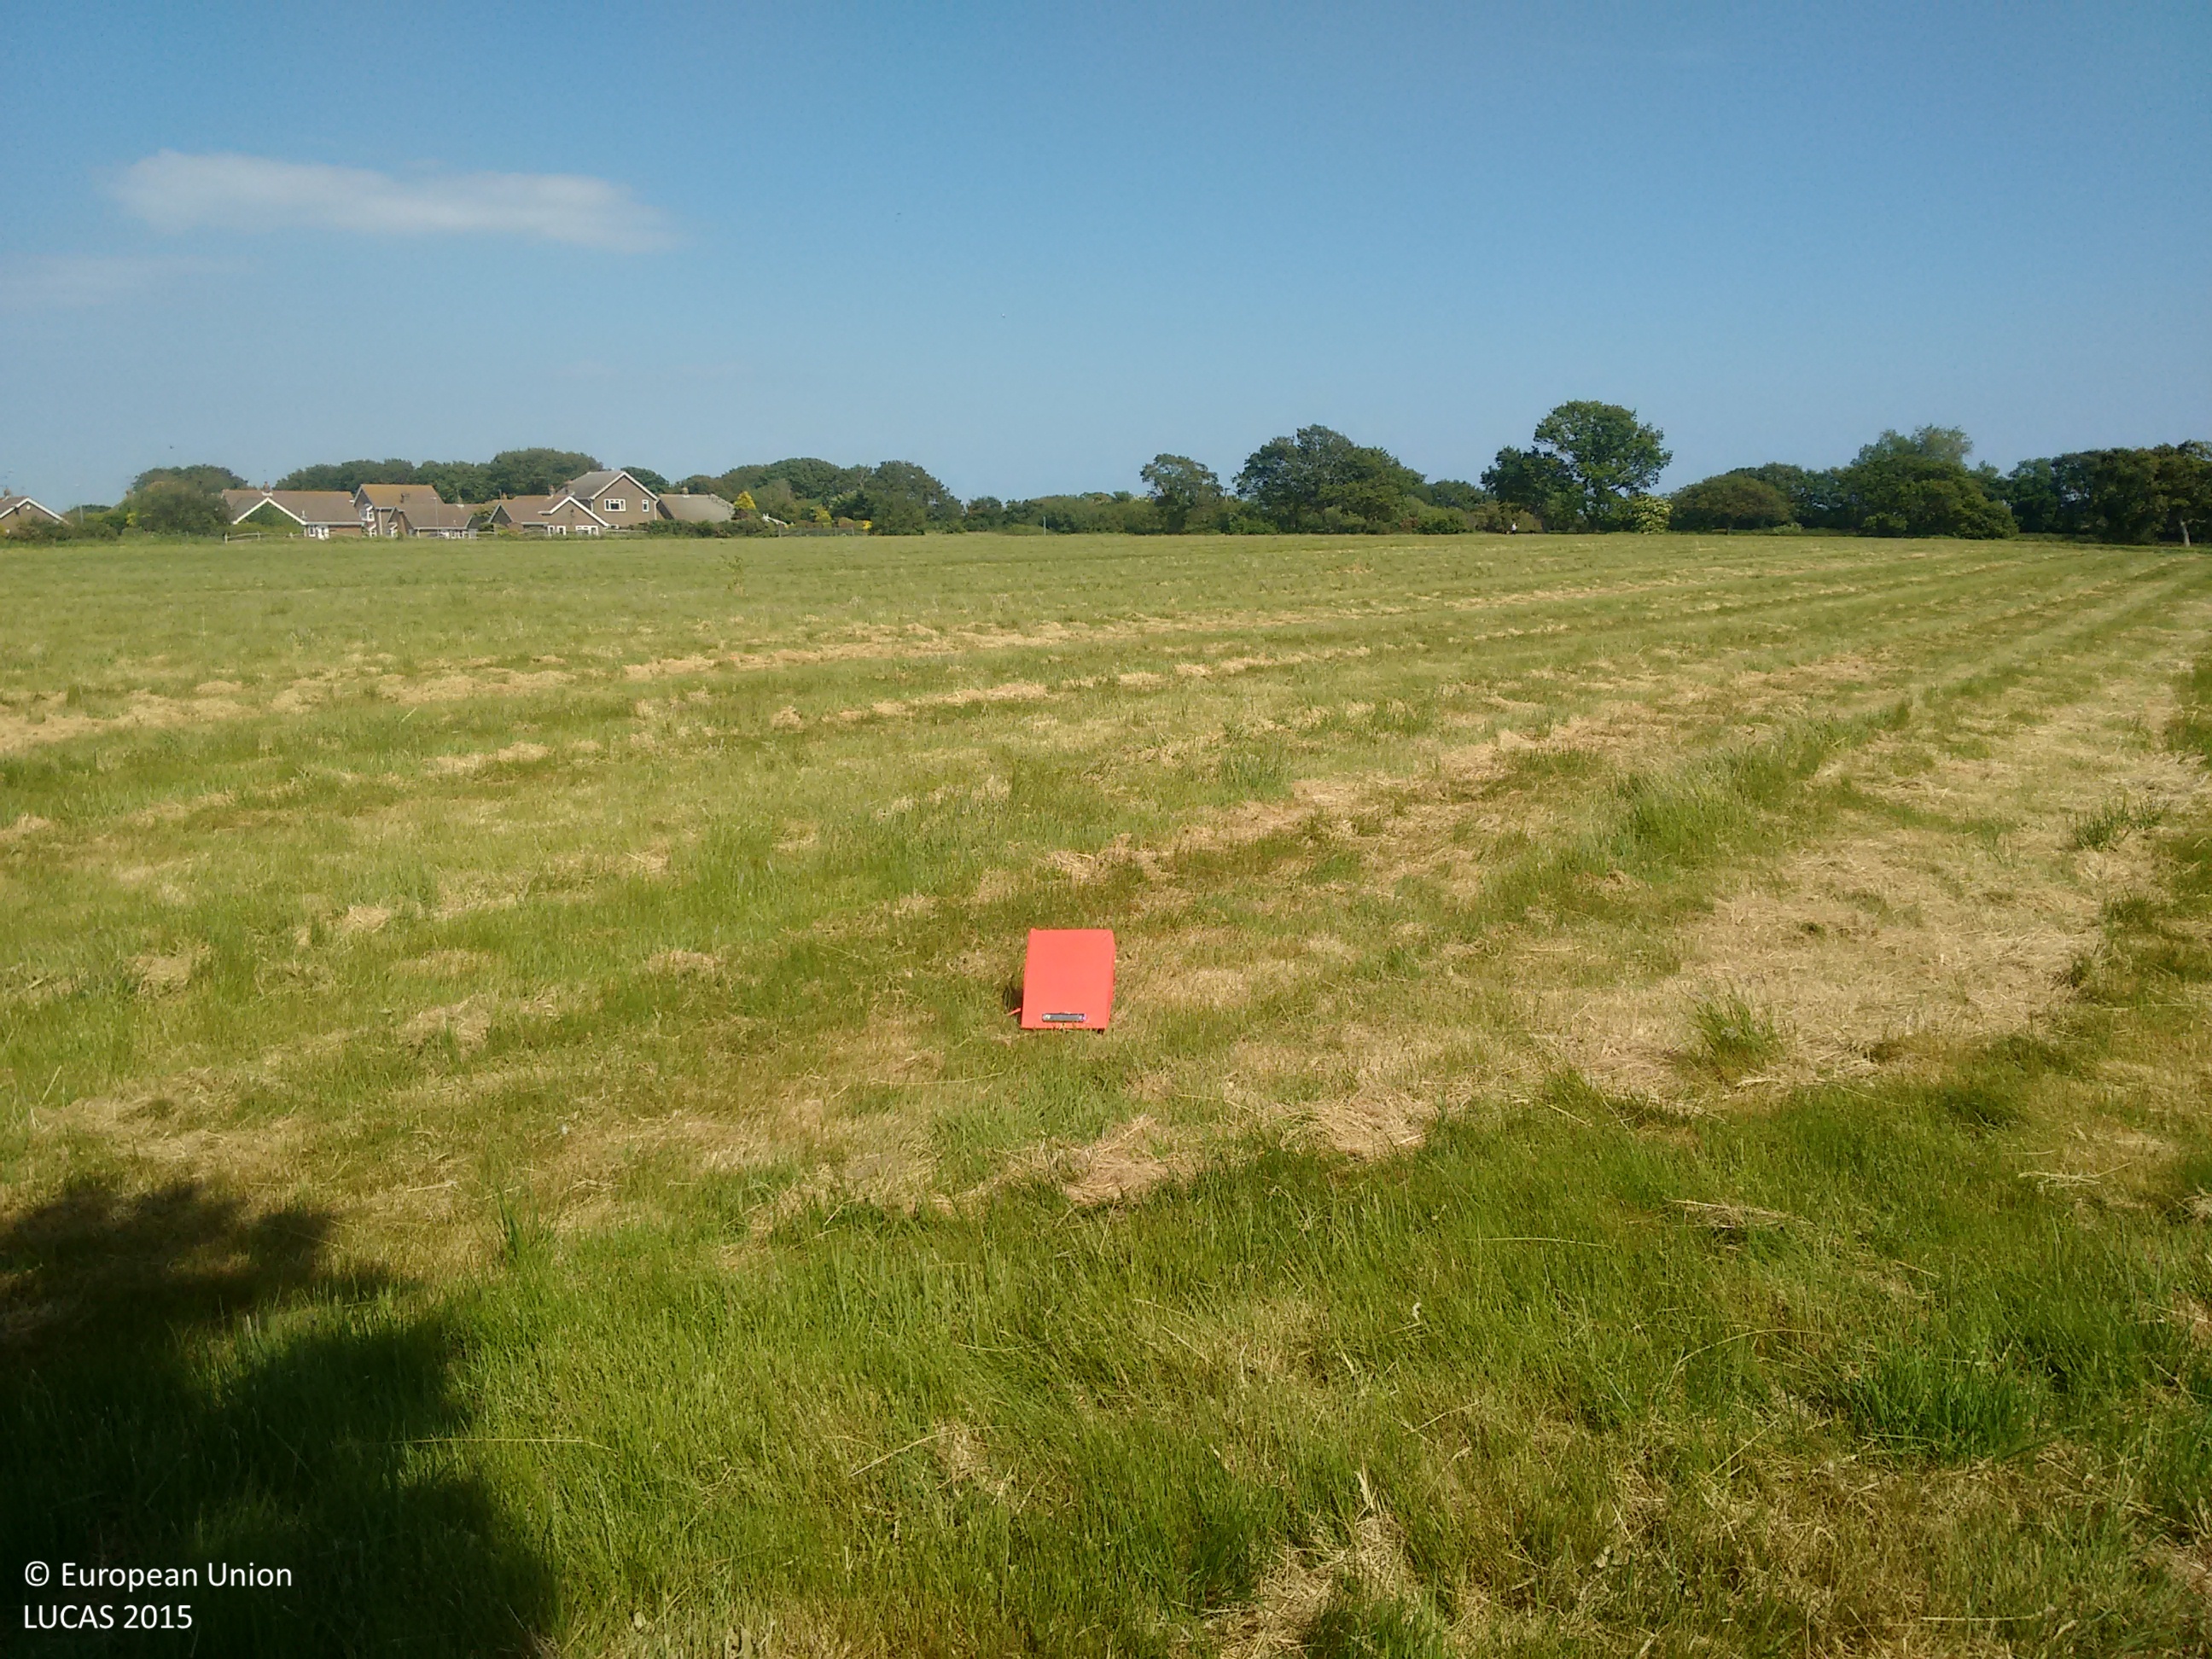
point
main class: Grassland
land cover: Grassland without tree/shrub cover
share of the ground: > 75 %
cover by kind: herbaceous plants 100 %
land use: Amenities, museums, leisure
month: June
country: GB
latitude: 50.8158
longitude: 0.2473
